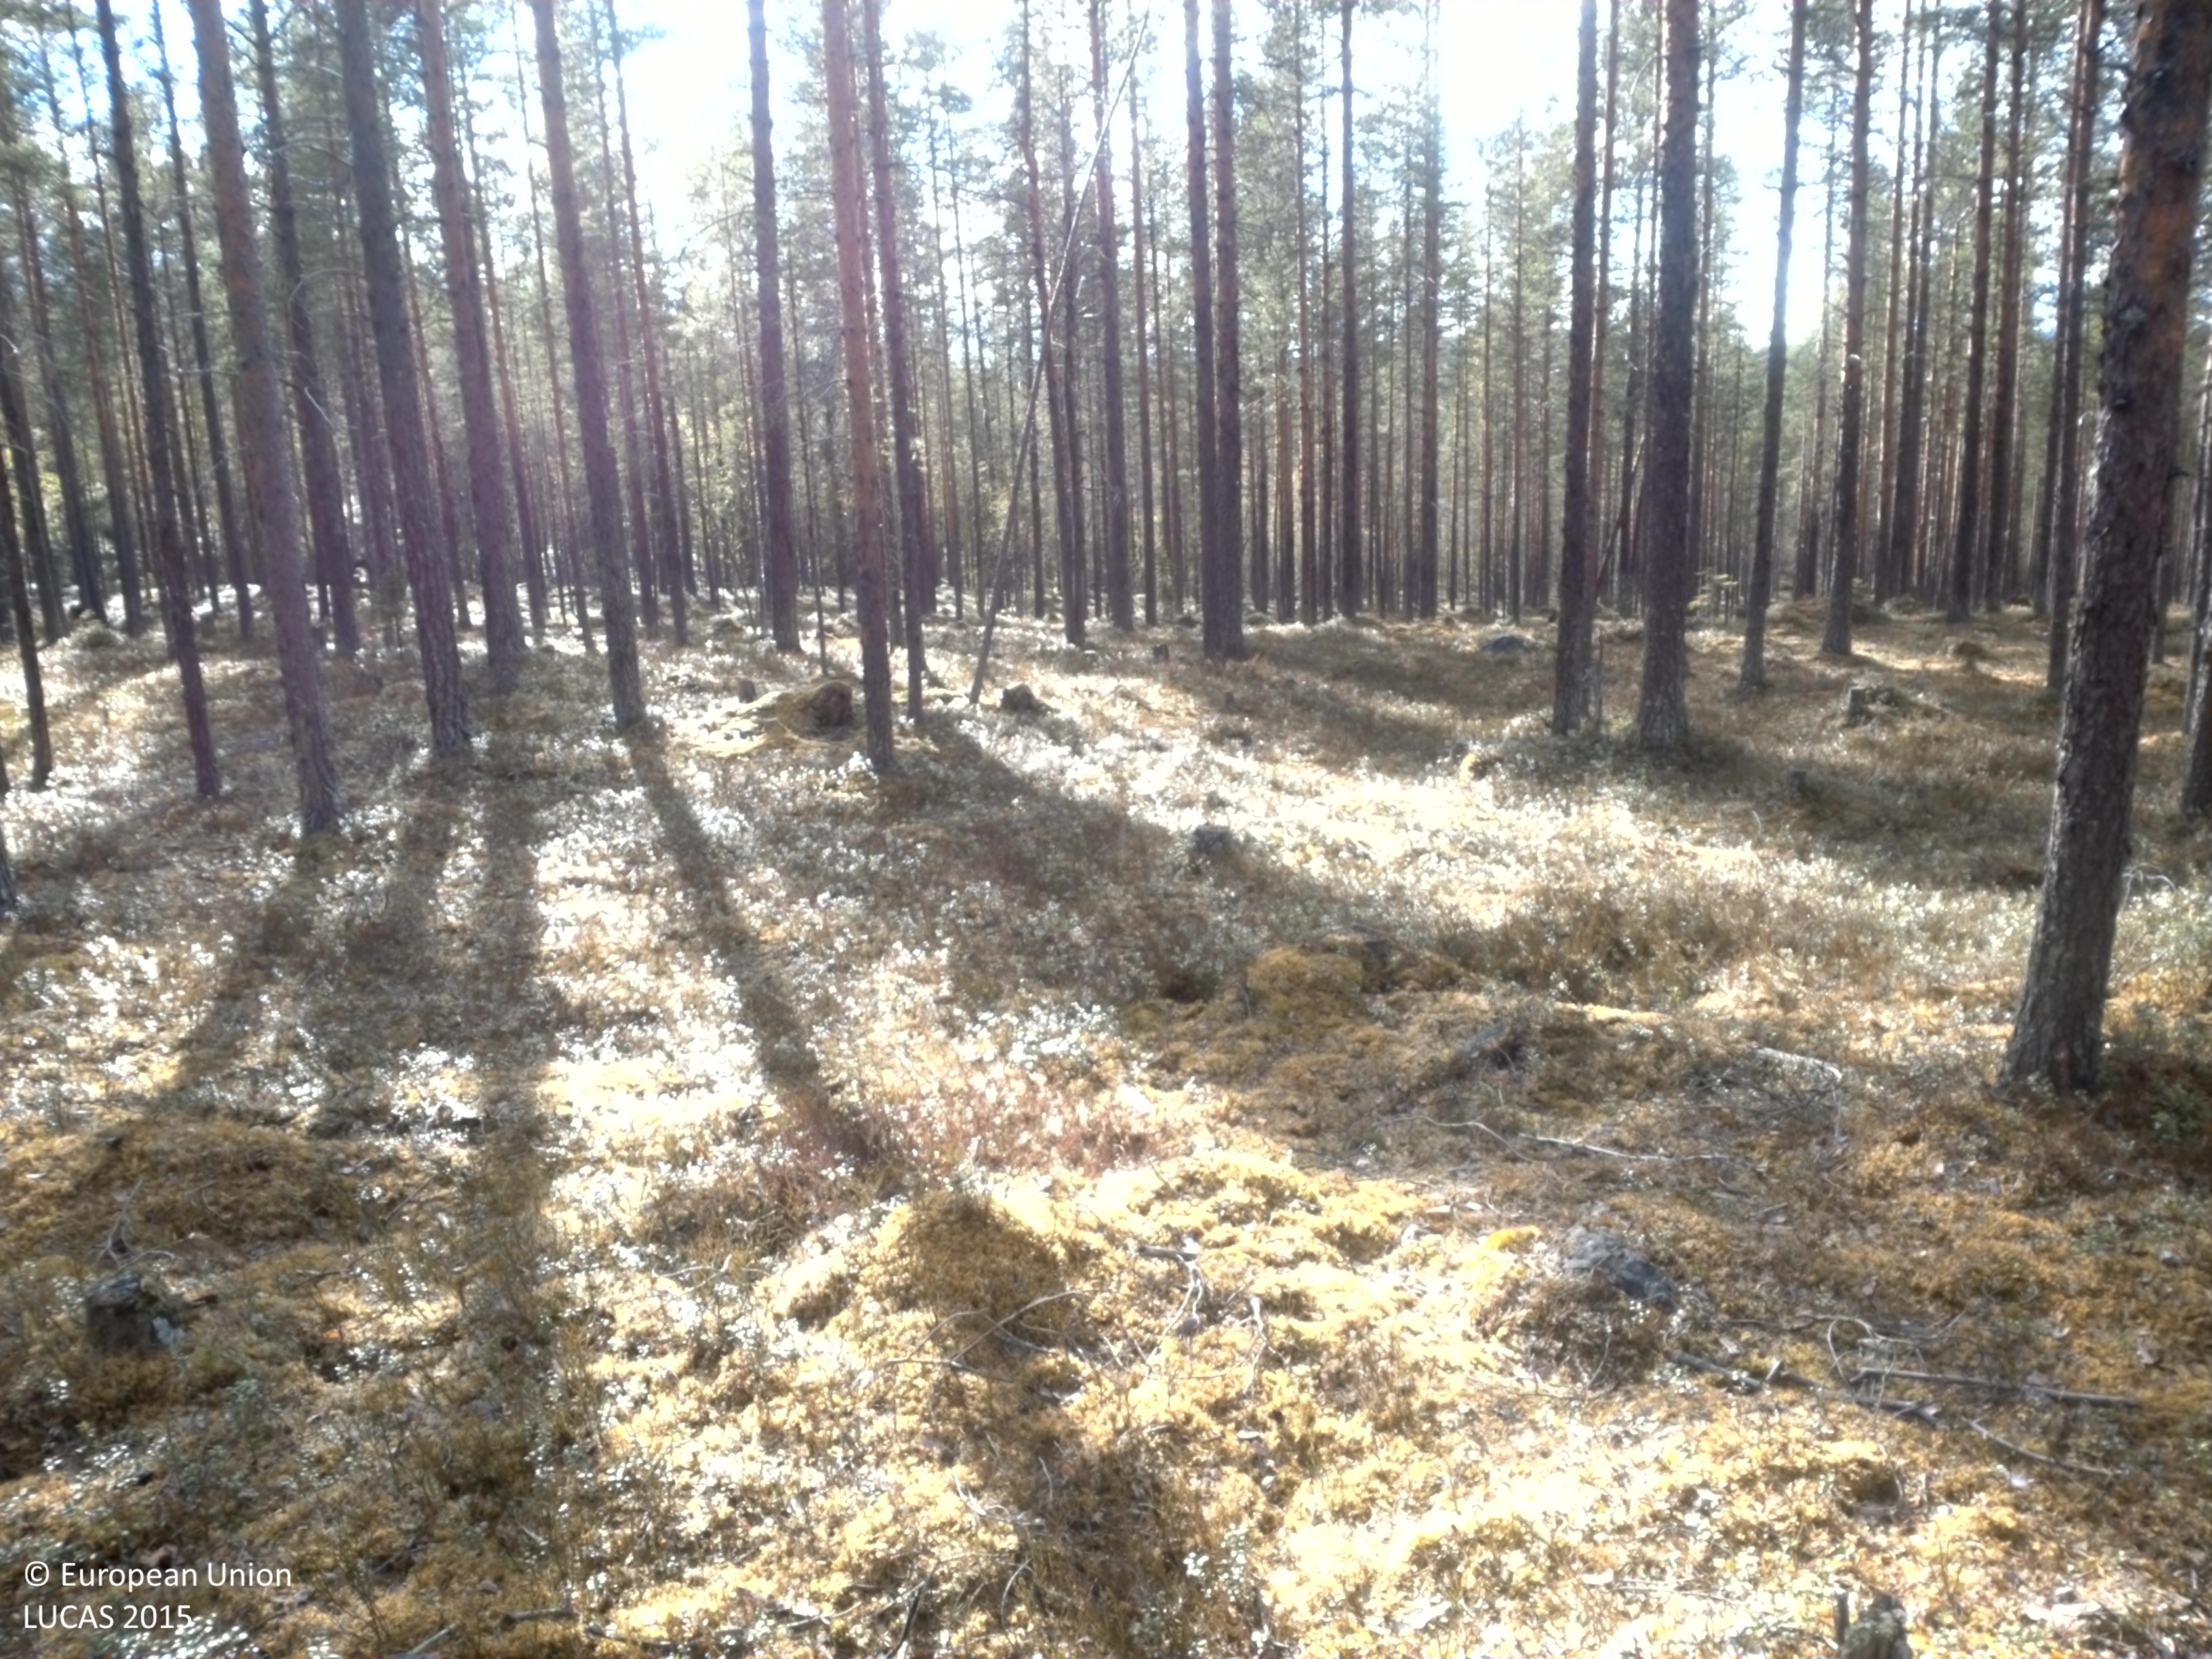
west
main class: Woodland
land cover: Pine dominated coniferous woodland
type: boreal forest
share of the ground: 25 - 50 %
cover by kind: lichens and mosses 45 %, coniferous forest trees 35 %, herbaceous plants 20 %
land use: Forestry
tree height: > 5 m
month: June
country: SE
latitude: 64.2785
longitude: 18.1681
